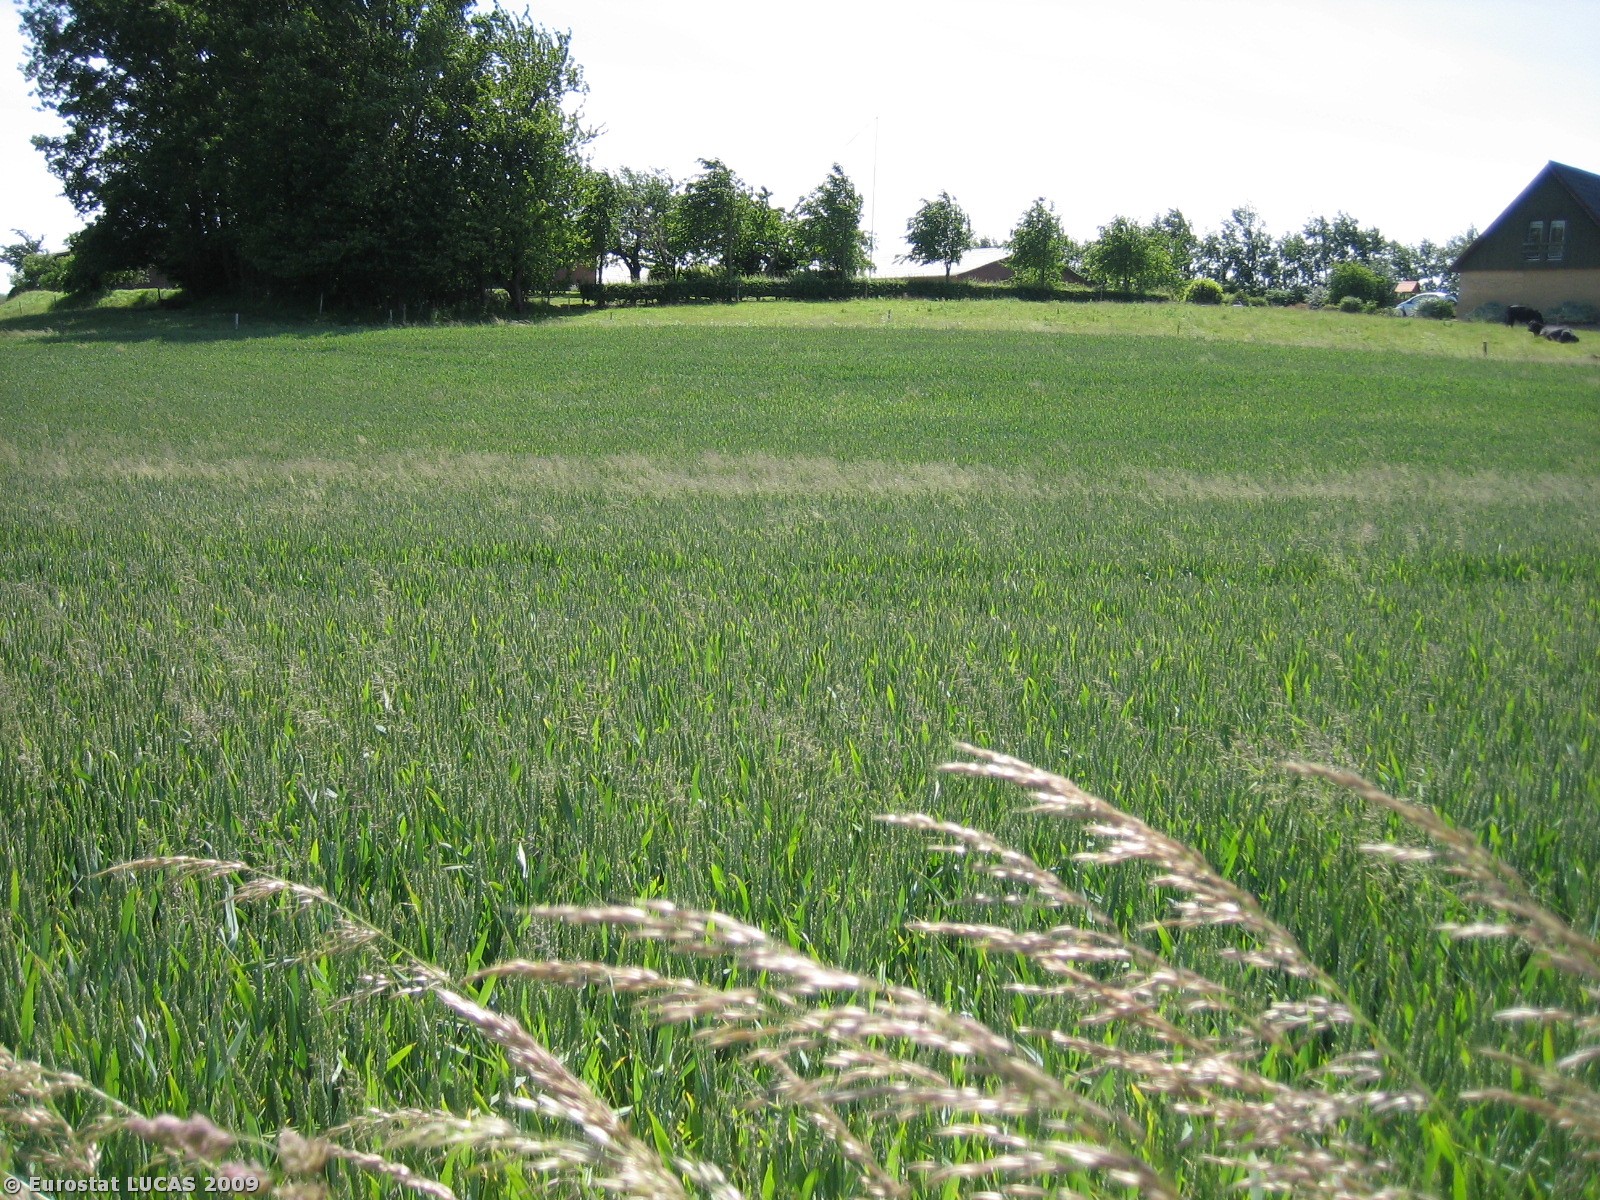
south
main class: Cropland
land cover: Common wheat
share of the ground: > 75 %
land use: Agriculture (excluding fallow land and kitchen gardens)
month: June
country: DK
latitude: 55.7024
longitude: 9.8887
